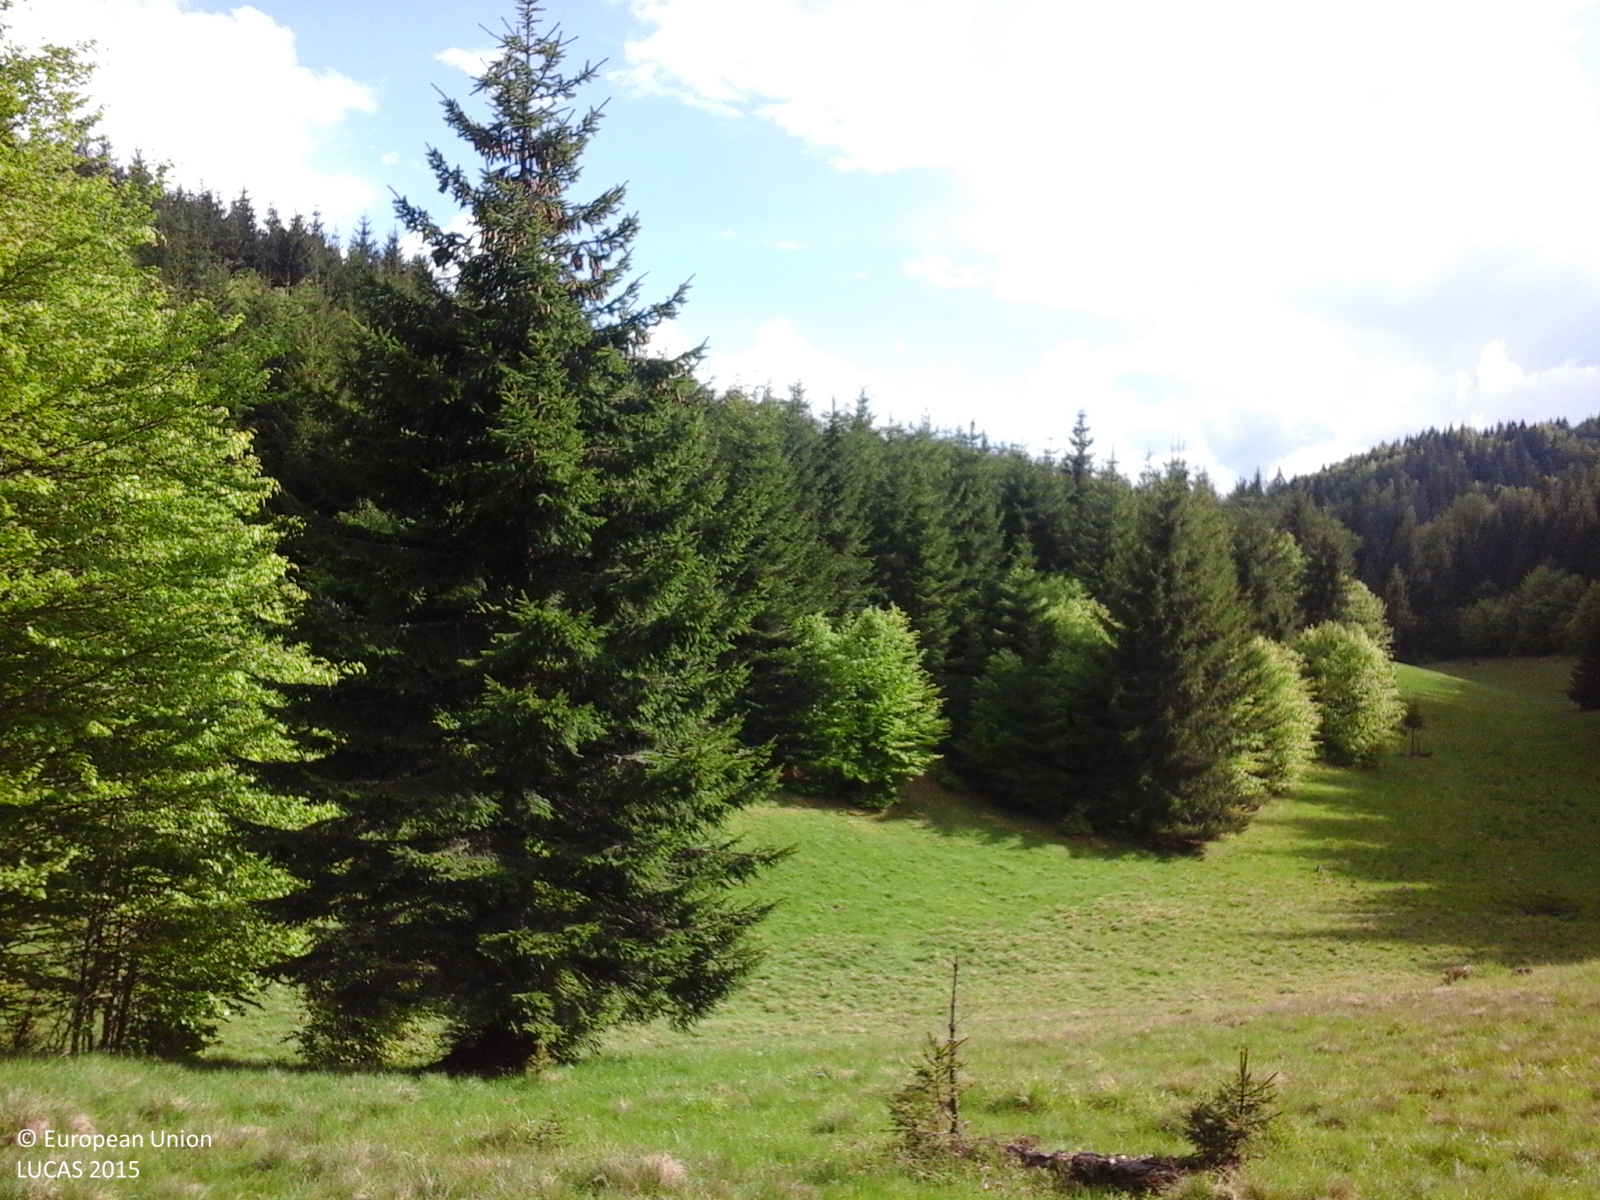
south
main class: Grassland
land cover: Grassland with sparse tree/shrub cover
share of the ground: > 75 %
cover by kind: herbaceous plants 90 %, coniferous forest trees 5 %, shrubs 5 %
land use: Forestry
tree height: < 5 m
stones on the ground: < 10 %
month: May
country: RO
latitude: 45.4904
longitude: 25.2318
